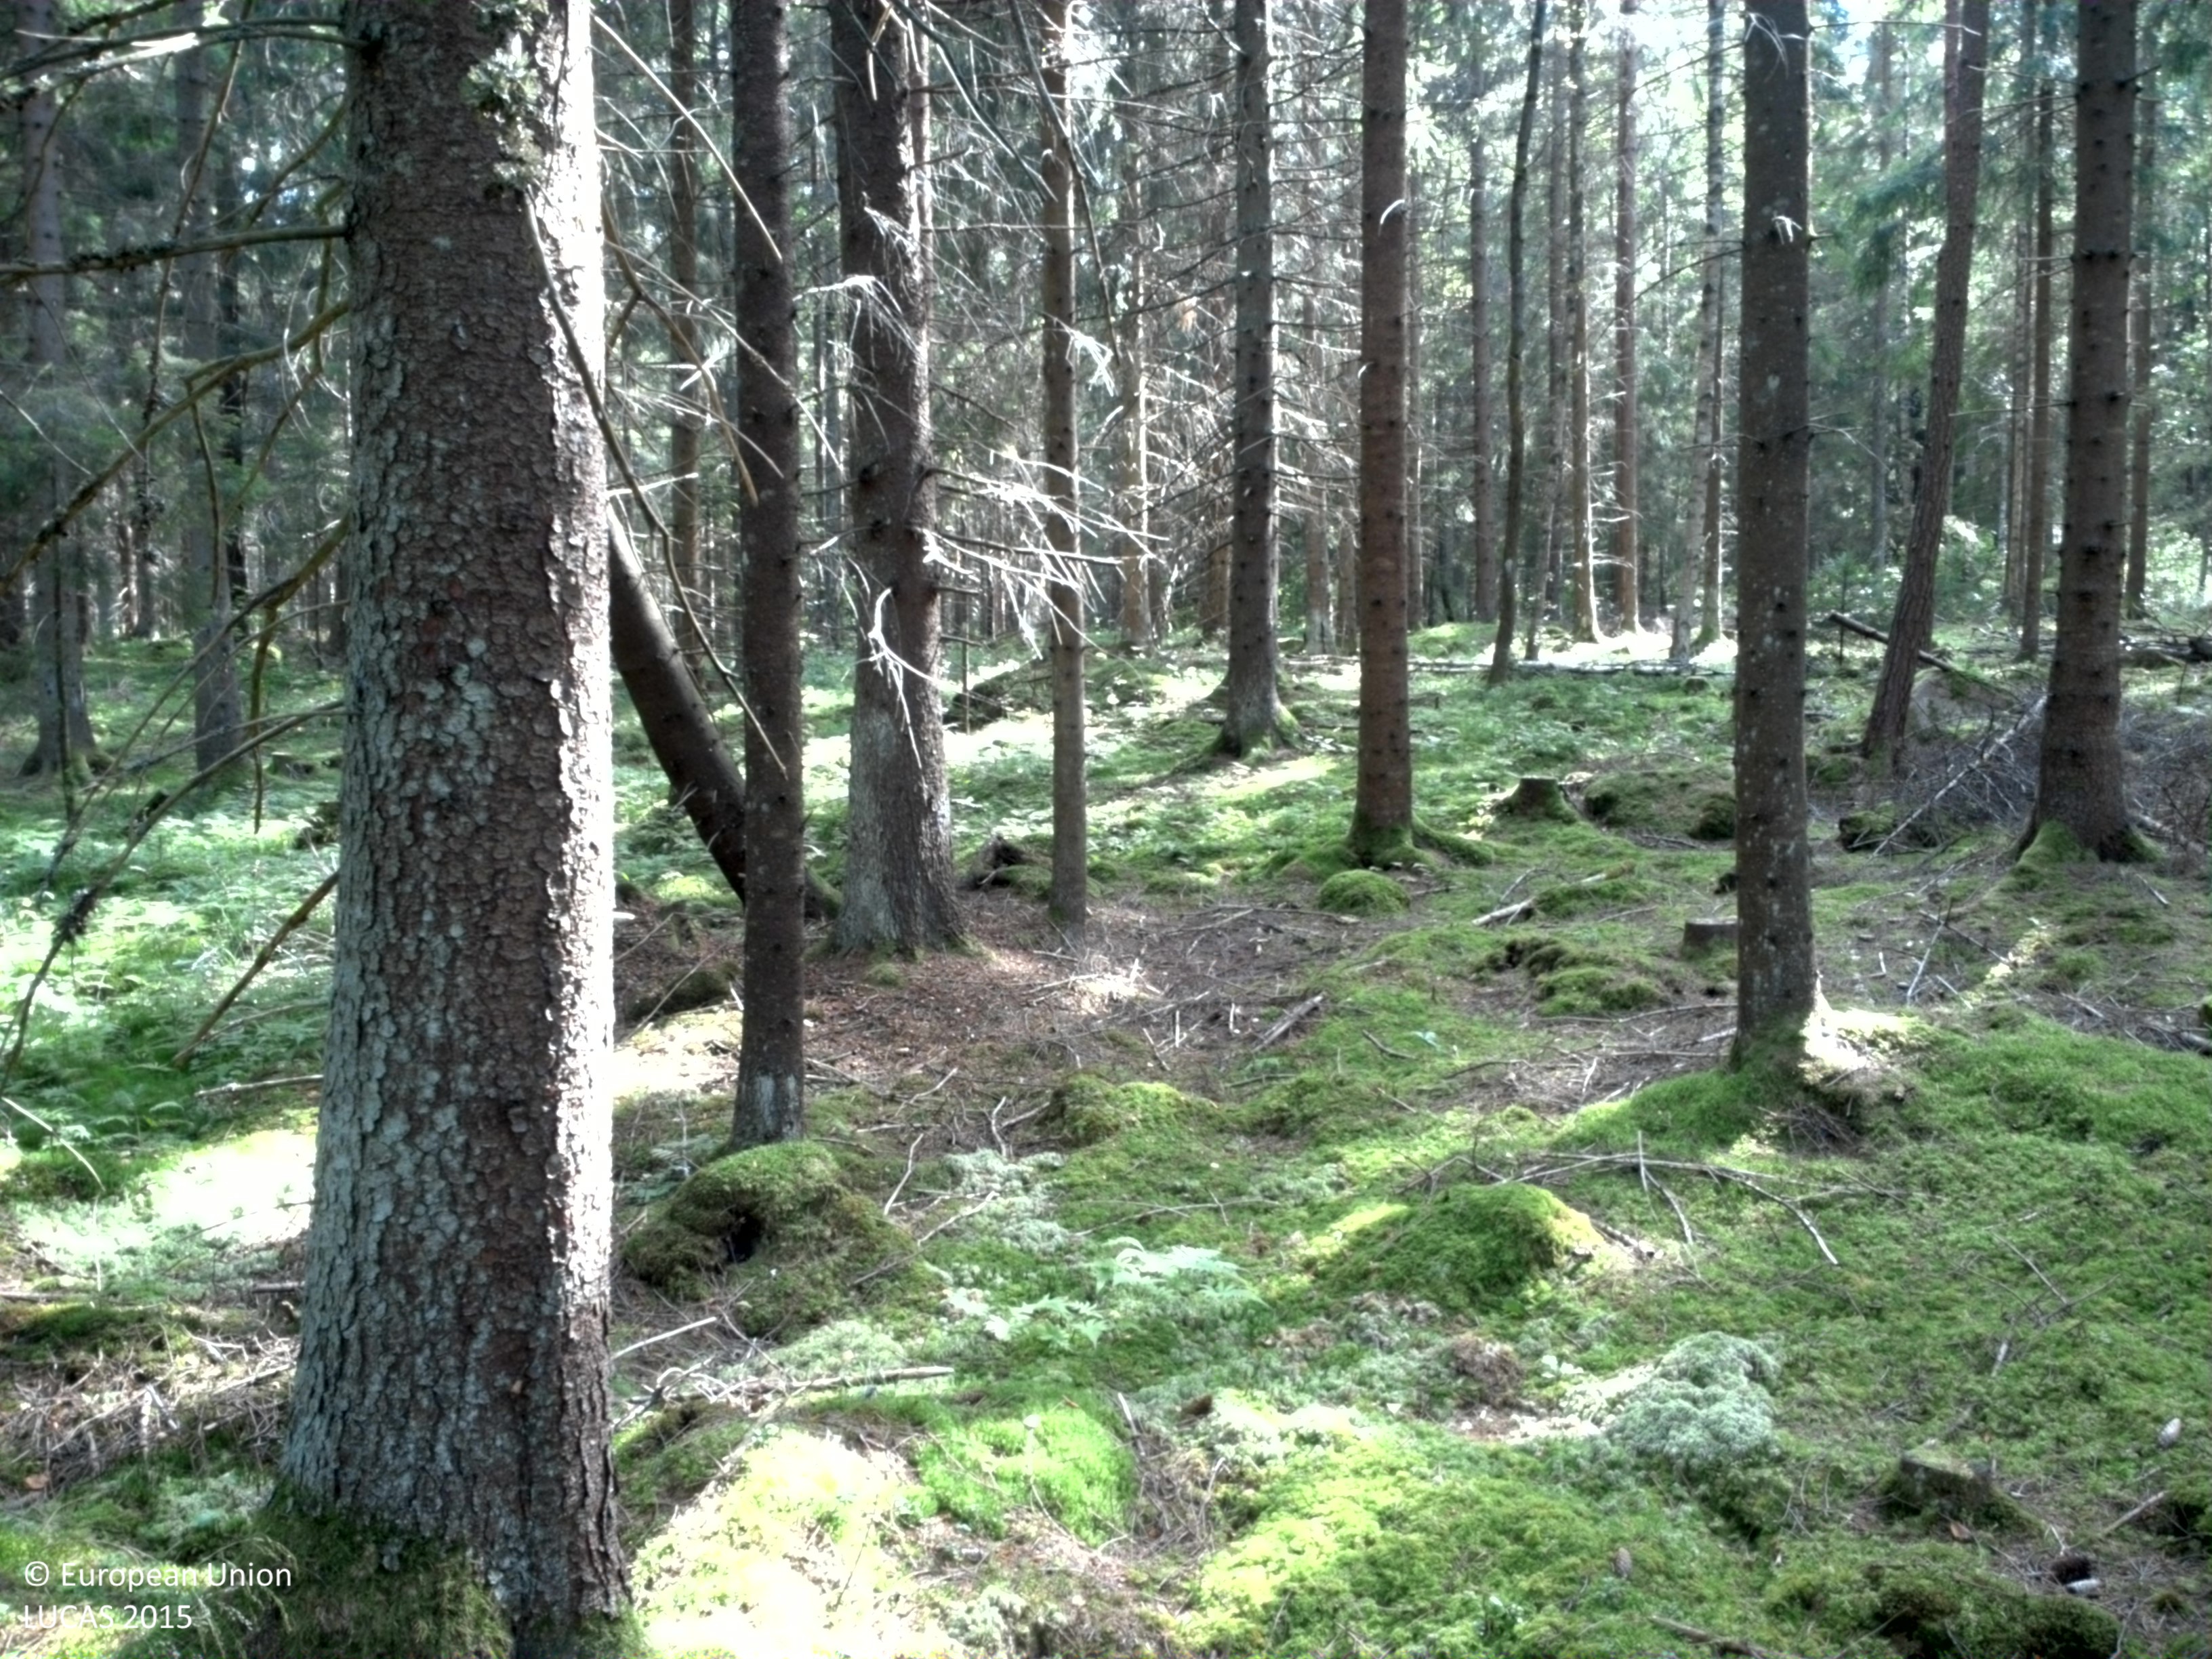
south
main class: Woodland
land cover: Spruce dominated coniferous woodland
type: boreal forest
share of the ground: 50 - 75 %
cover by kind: coniferous forest trees 55 %, lichens and mosses 35 %, shrubs 5 %, herbaceous plants 5 %
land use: Forestry
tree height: > 5 m
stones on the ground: < 10 %
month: August
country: SE
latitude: 58.7888
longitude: 14.0588
